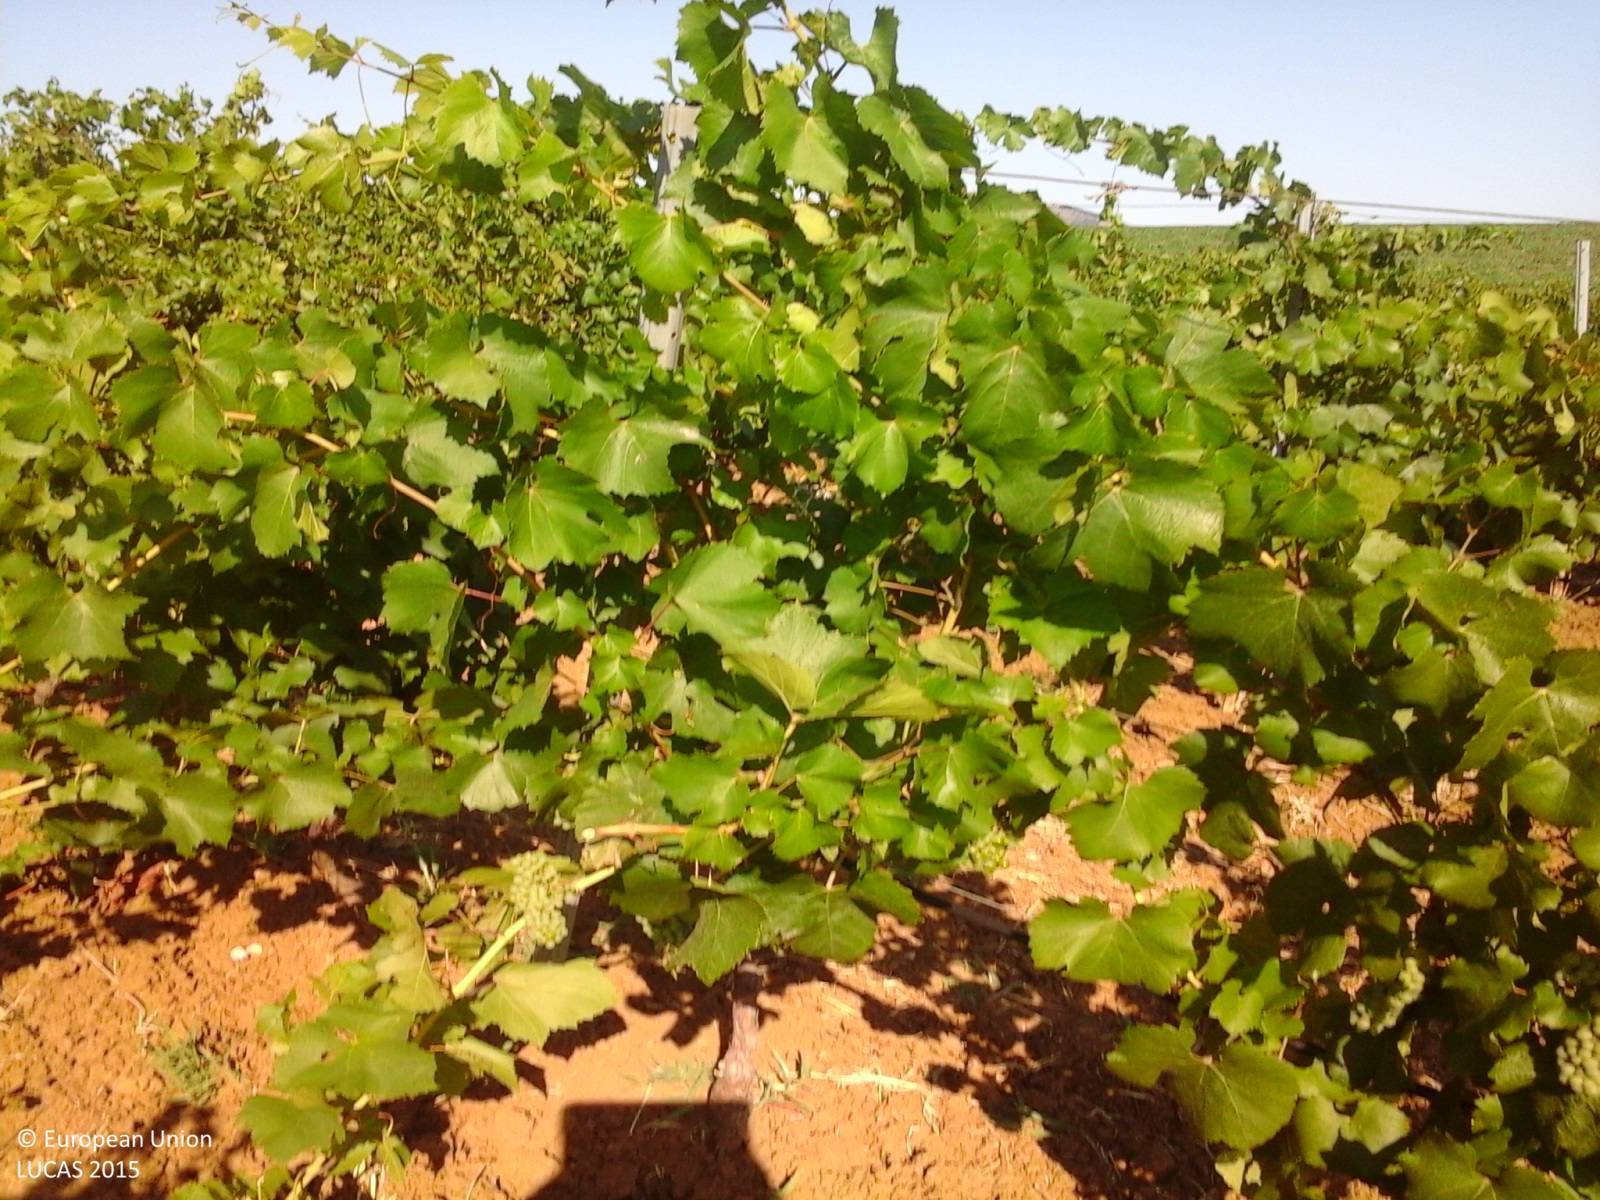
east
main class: Cropland
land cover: Vineyards
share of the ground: 50 - 75 %
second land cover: Other bare soil
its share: > 75 %
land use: Agriculture (excluding fallow land and kitchen gardens)
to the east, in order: Vineyards; Other bare soil; Other fresh vegetables; Spontaneously vegetated surfaces; Inland fresh water bodies; Spontaneously vegetated surfaces; Other fresh vegetables
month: June
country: IT
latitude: 37.9097
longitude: 12.6760
